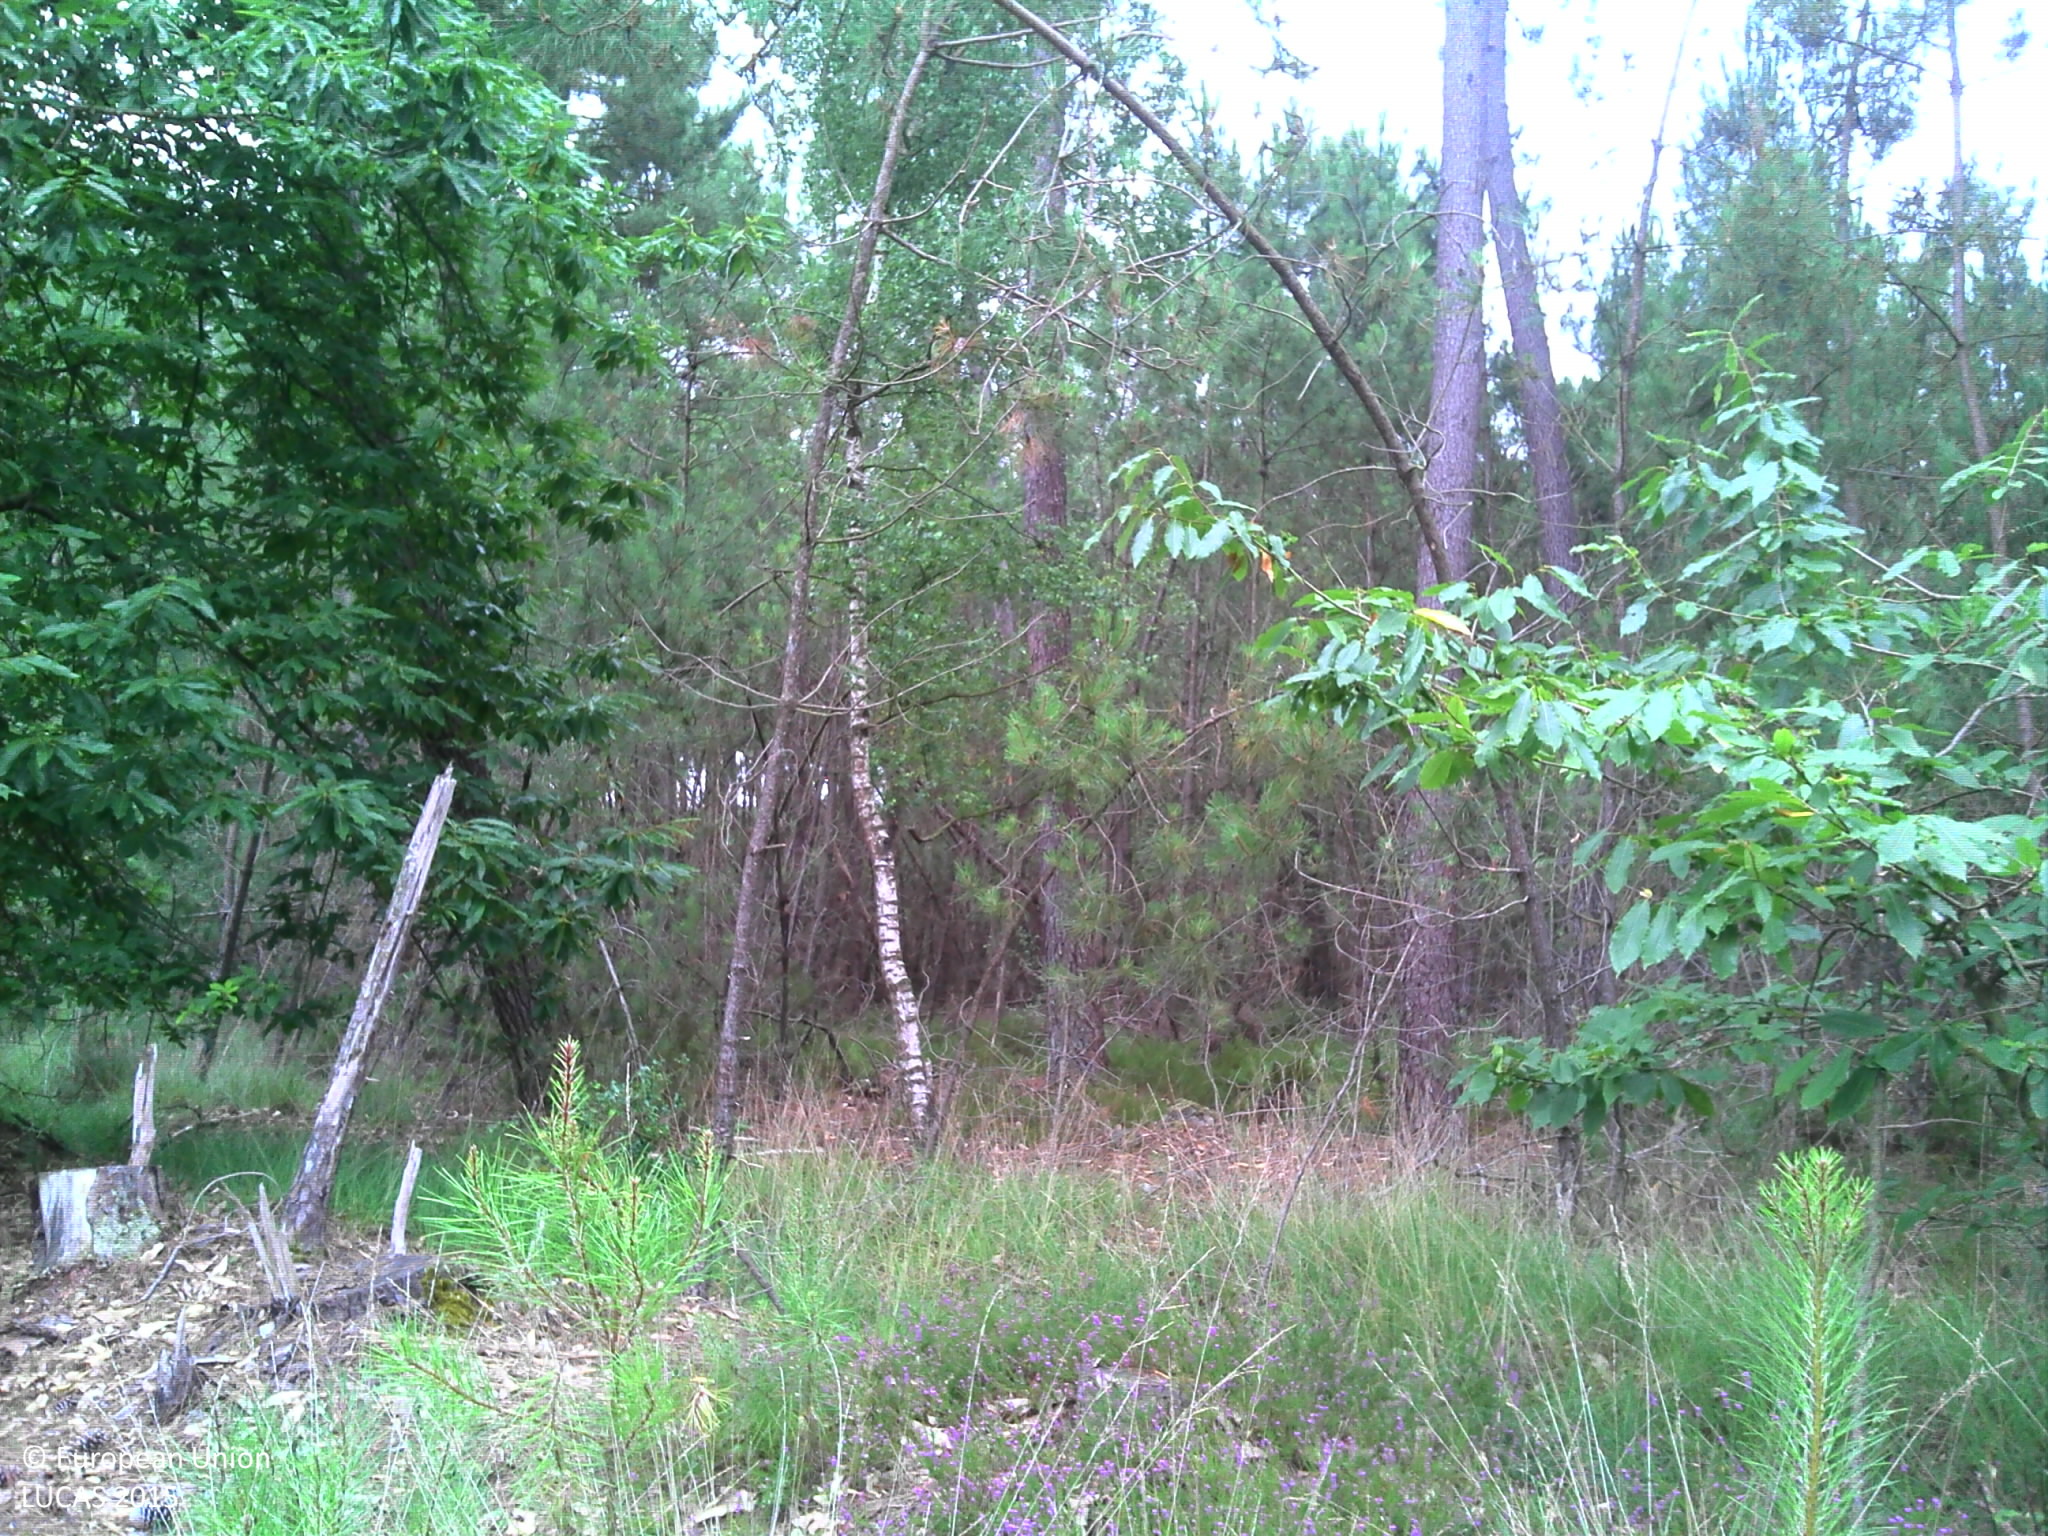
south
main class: Woodland
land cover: Pine dominated coniferous woodland
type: exotic forest
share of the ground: 50 - 75 %
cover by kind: coniferous forest trees 50 %, herbaceous plants 30 %, shrubs 20 %
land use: Forestry
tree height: < 5 m
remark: Nursery
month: July
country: FR
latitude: 47.8776
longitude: 0.4161
